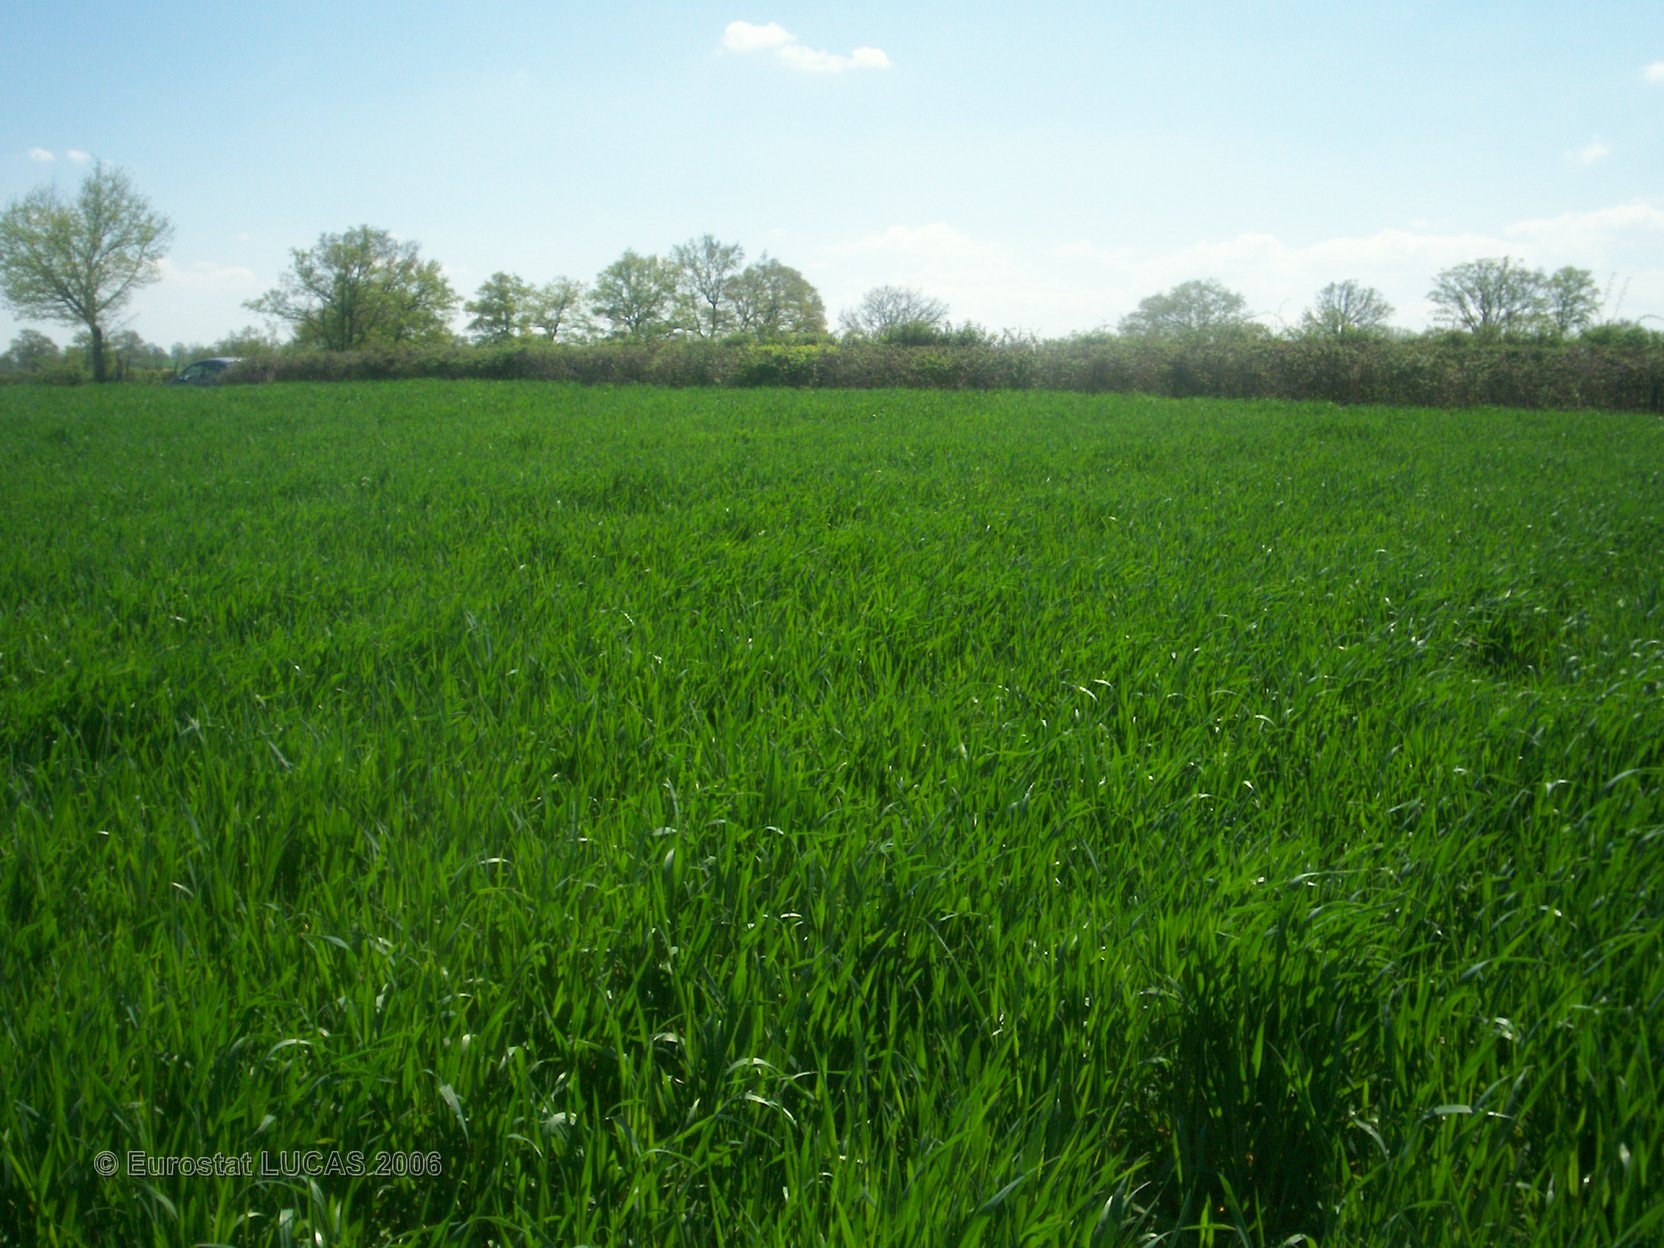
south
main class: Cropland
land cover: Common wheat
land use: Agriculture (excluding fallow land and kitchen gardens)
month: May
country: FR
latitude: 46.1685
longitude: 2.8872
